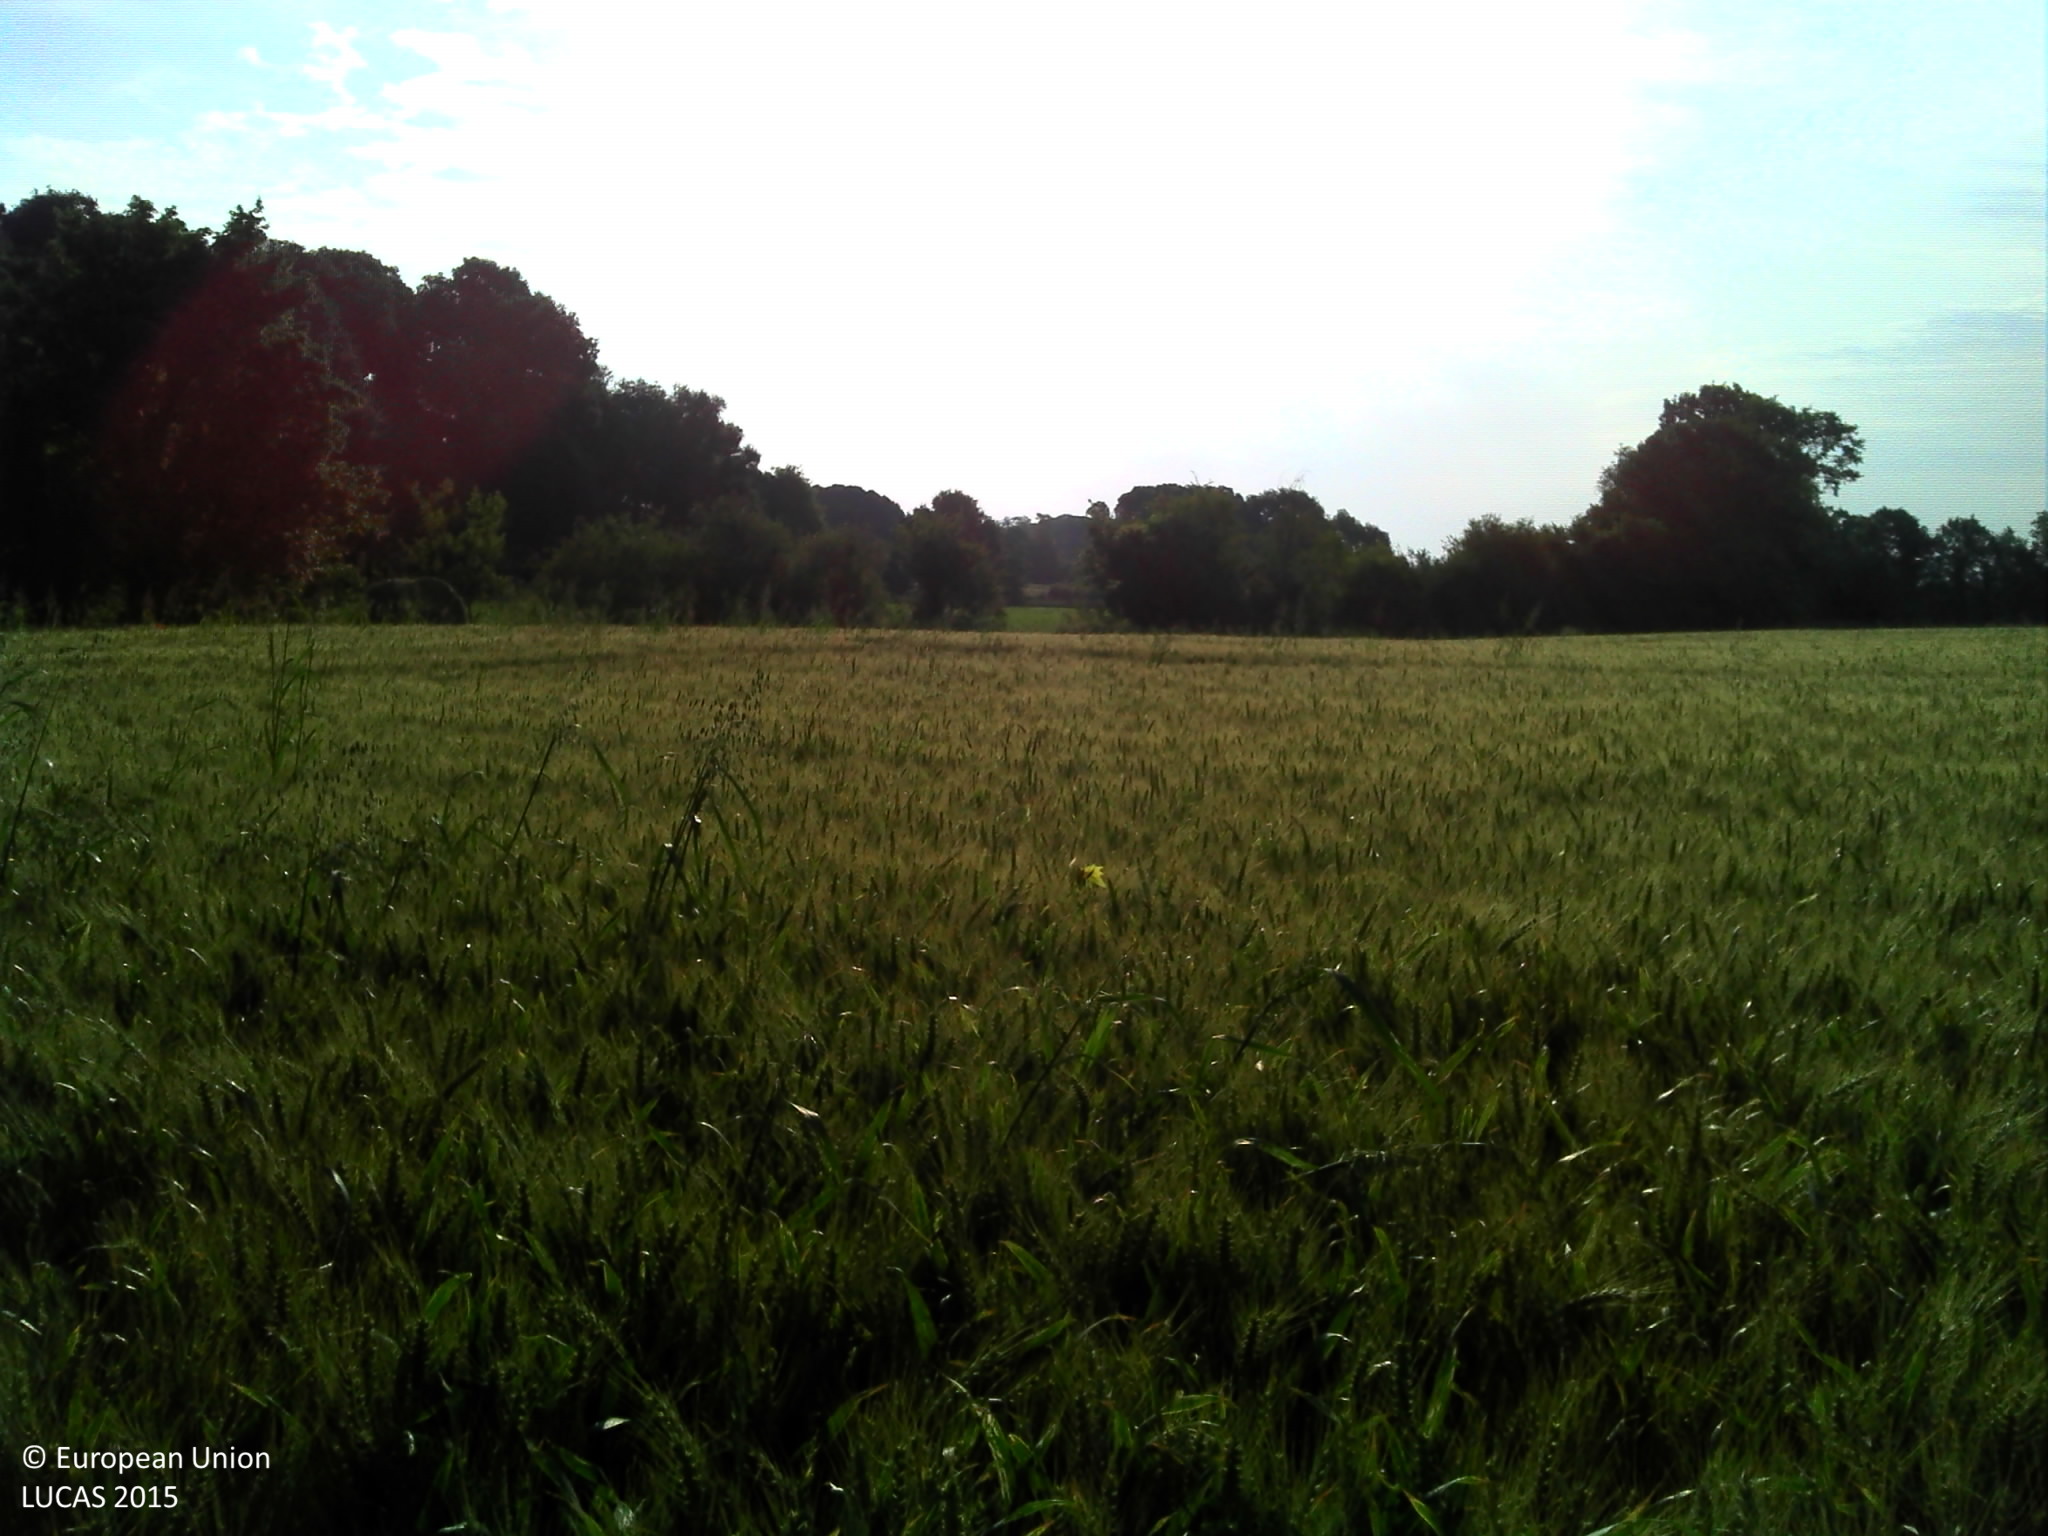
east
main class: Cropland
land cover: Triticale
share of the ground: > 75 %
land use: Agriculture (excluding fallow land and kitchen gardens)
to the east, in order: Triticale; Grassland without tree/shrub cover; Spontaneously vegetated surfaces; Lines of trees; Ditches and canals; Spontaneously vegetated surfaces; Grassland without tree/shrub cover; Maize
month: June
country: FR
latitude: 48.1612
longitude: -1.7049
